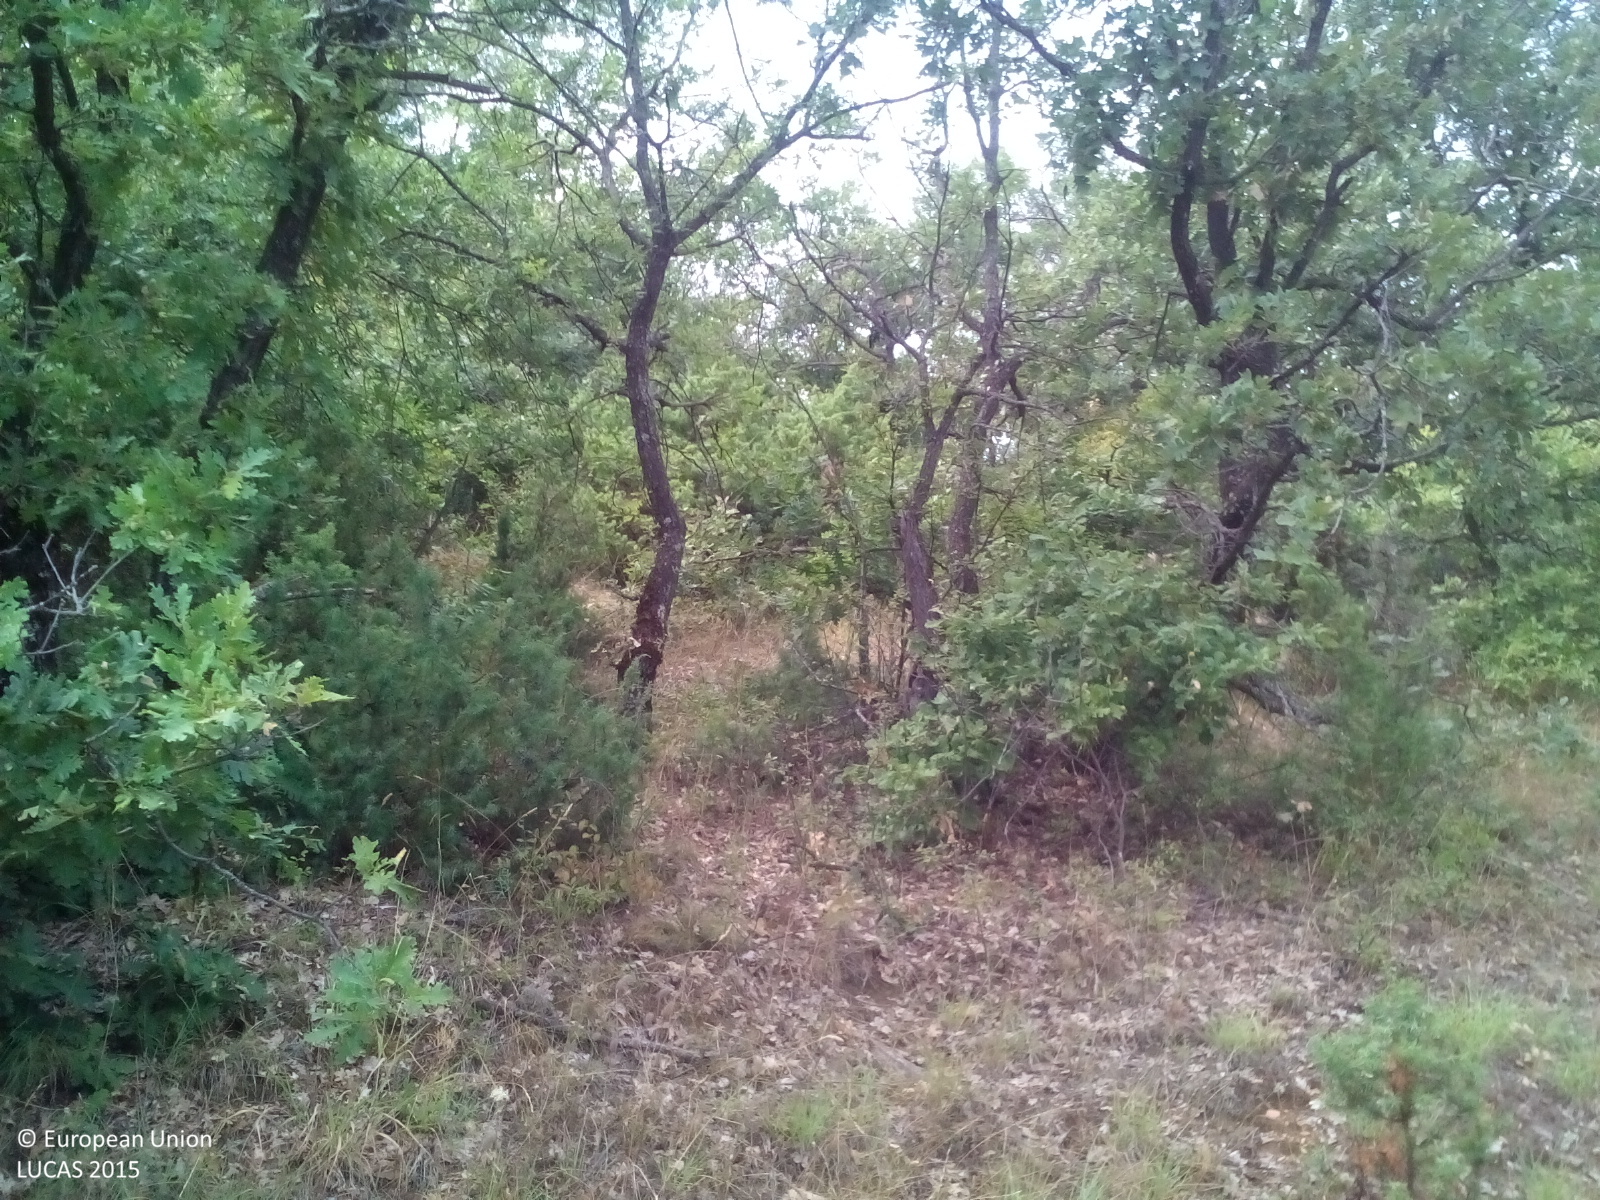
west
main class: Woodland
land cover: Broadleaved woodland
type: thermophilous deciduous forest
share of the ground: 50 - 75 %
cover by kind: broadleaved forest trees 60 %, herbaceous plants 30 %, shrubs 10 %
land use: Semi-natural and natural areas not in use
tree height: > 5 m
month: August
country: GR
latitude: 40.8039
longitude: 21.4088
